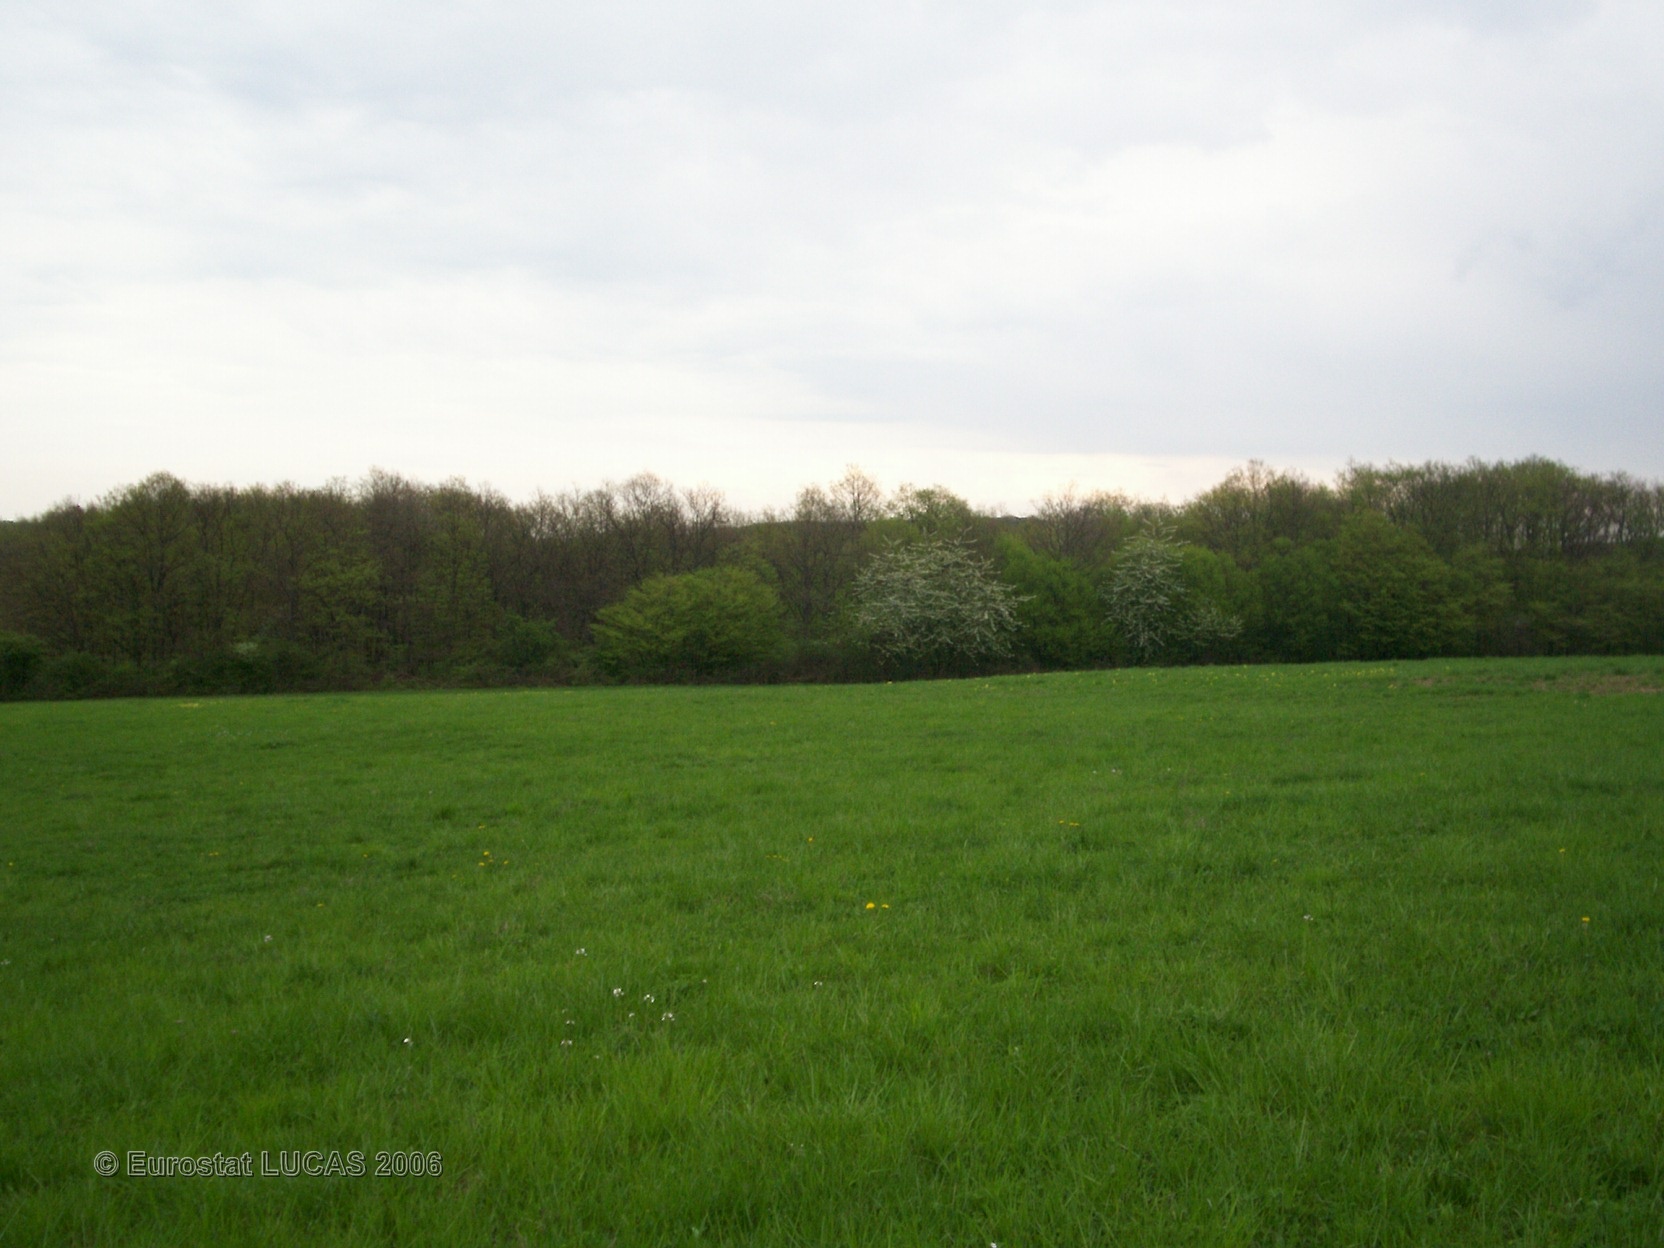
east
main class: Grassland
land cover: Grassland without tree/shrub cover
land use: Agriculture (excluding fallow land and kitchen gardens)
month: April
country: FR
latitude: 46.8317
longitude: 4.6651
